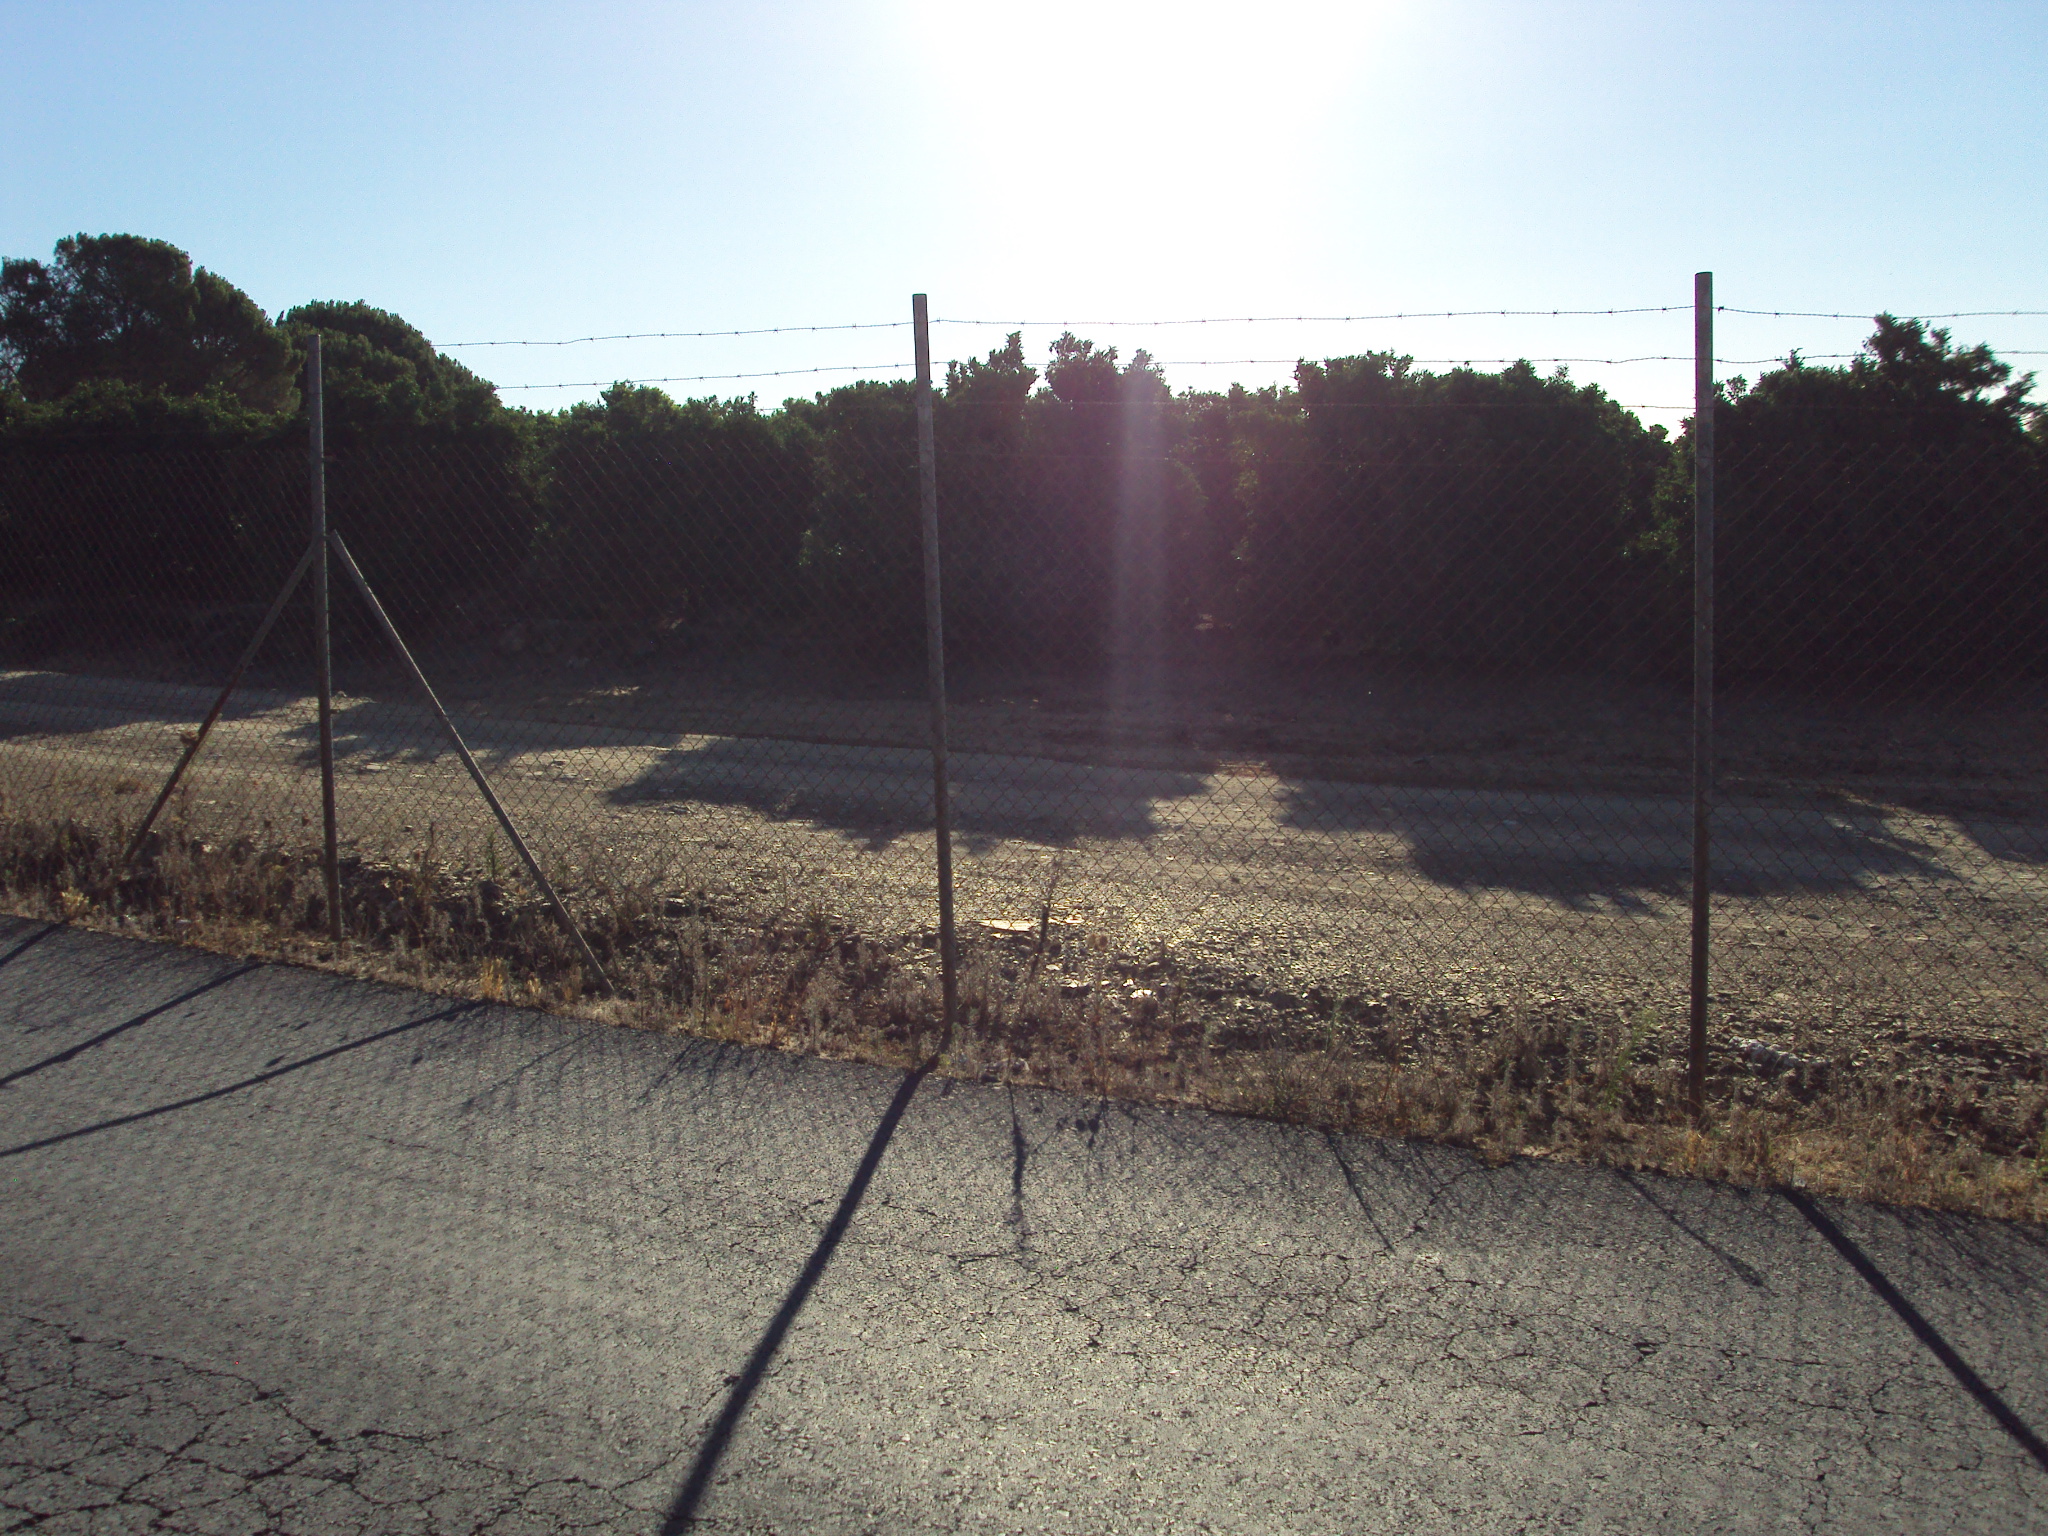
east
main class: Cropland
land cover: Oranges
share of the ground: > 75 %
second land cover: Other bare soil
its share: > 75 %
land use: Agriculture (excluding fallow land and kitchen gardens)
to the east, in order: Oranges; Other bare soil; Fences; Ditches and canals; Paved roads, cycling and walking lanes; Grass margins; Fences; Tracks; Oranges
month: July
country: ES
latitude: 37.4153
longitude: -7.0480
